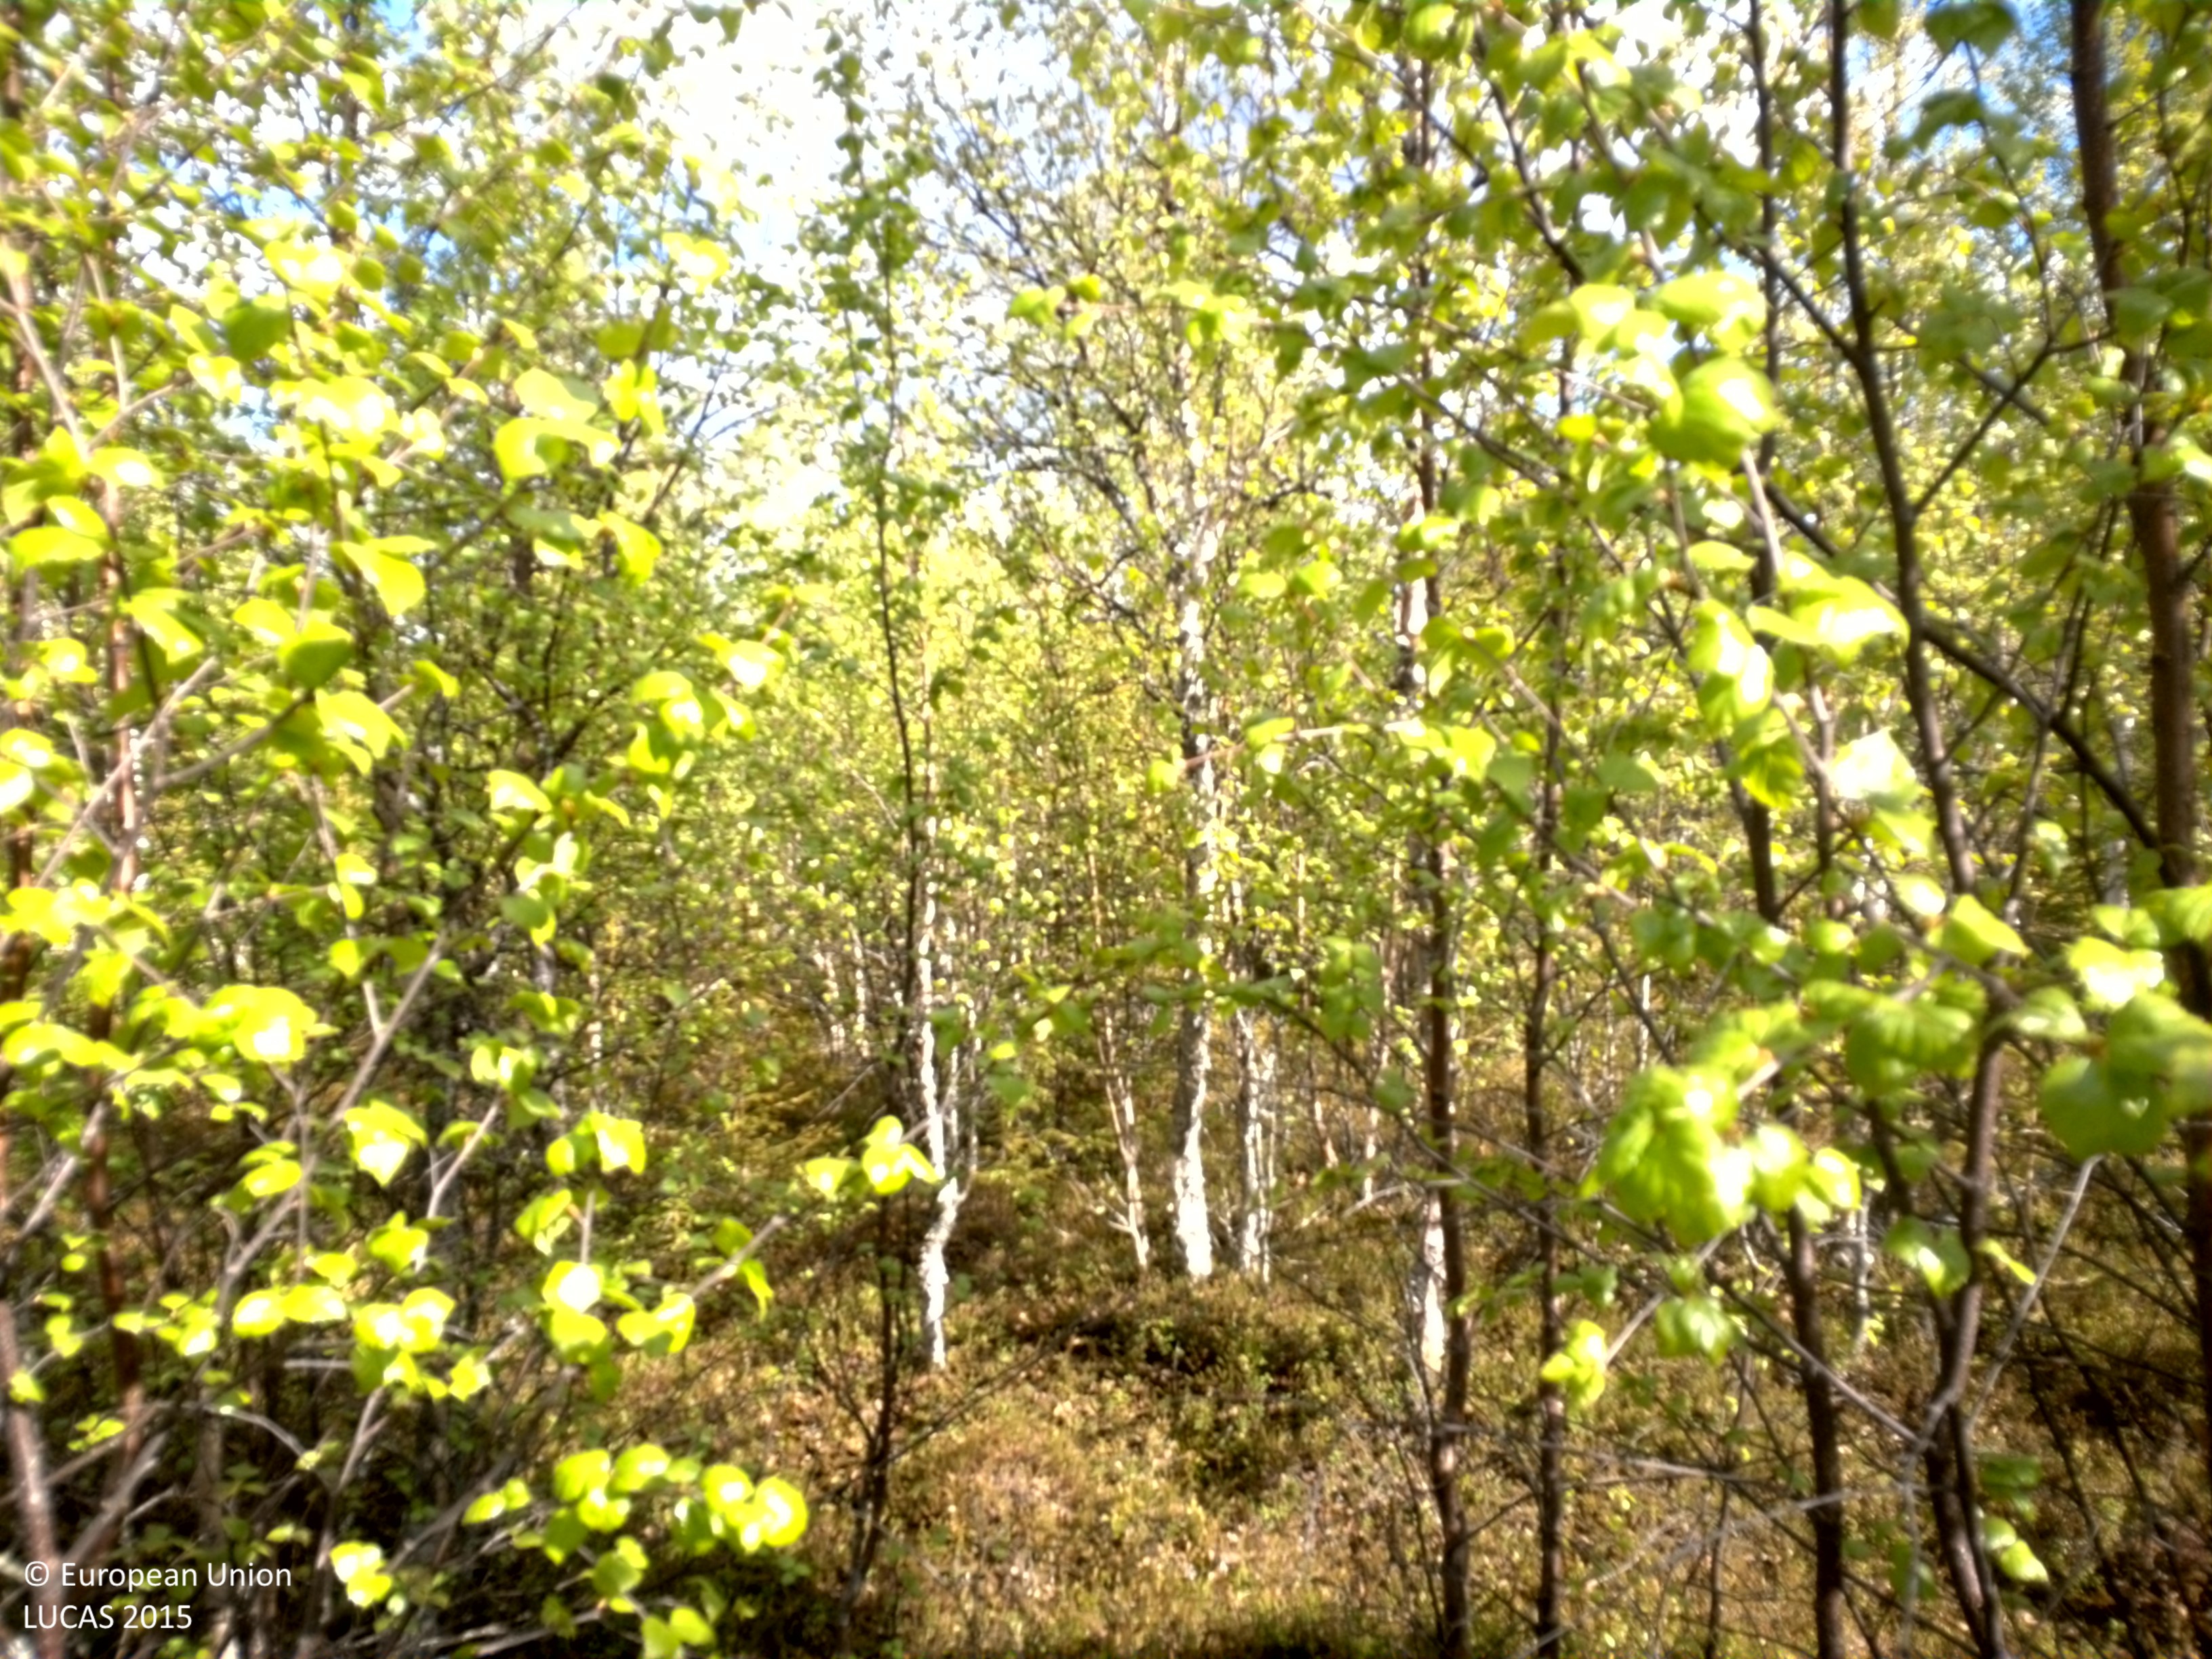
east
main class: Woodland
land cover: Broadleaved woodland
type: boreal forest
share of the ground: 50 - 75 %
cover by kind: broadleaved forest trees 65 %, herbaceous plants 15 %, coniferous forest trees 10 %, lichens and mosses 10 %
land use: Forestry
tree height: < 5 m
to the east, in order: Broadleaved woodland; Pine dominated mixed woodland
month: June
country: SE
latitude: 64.4081
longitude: 17.3752
